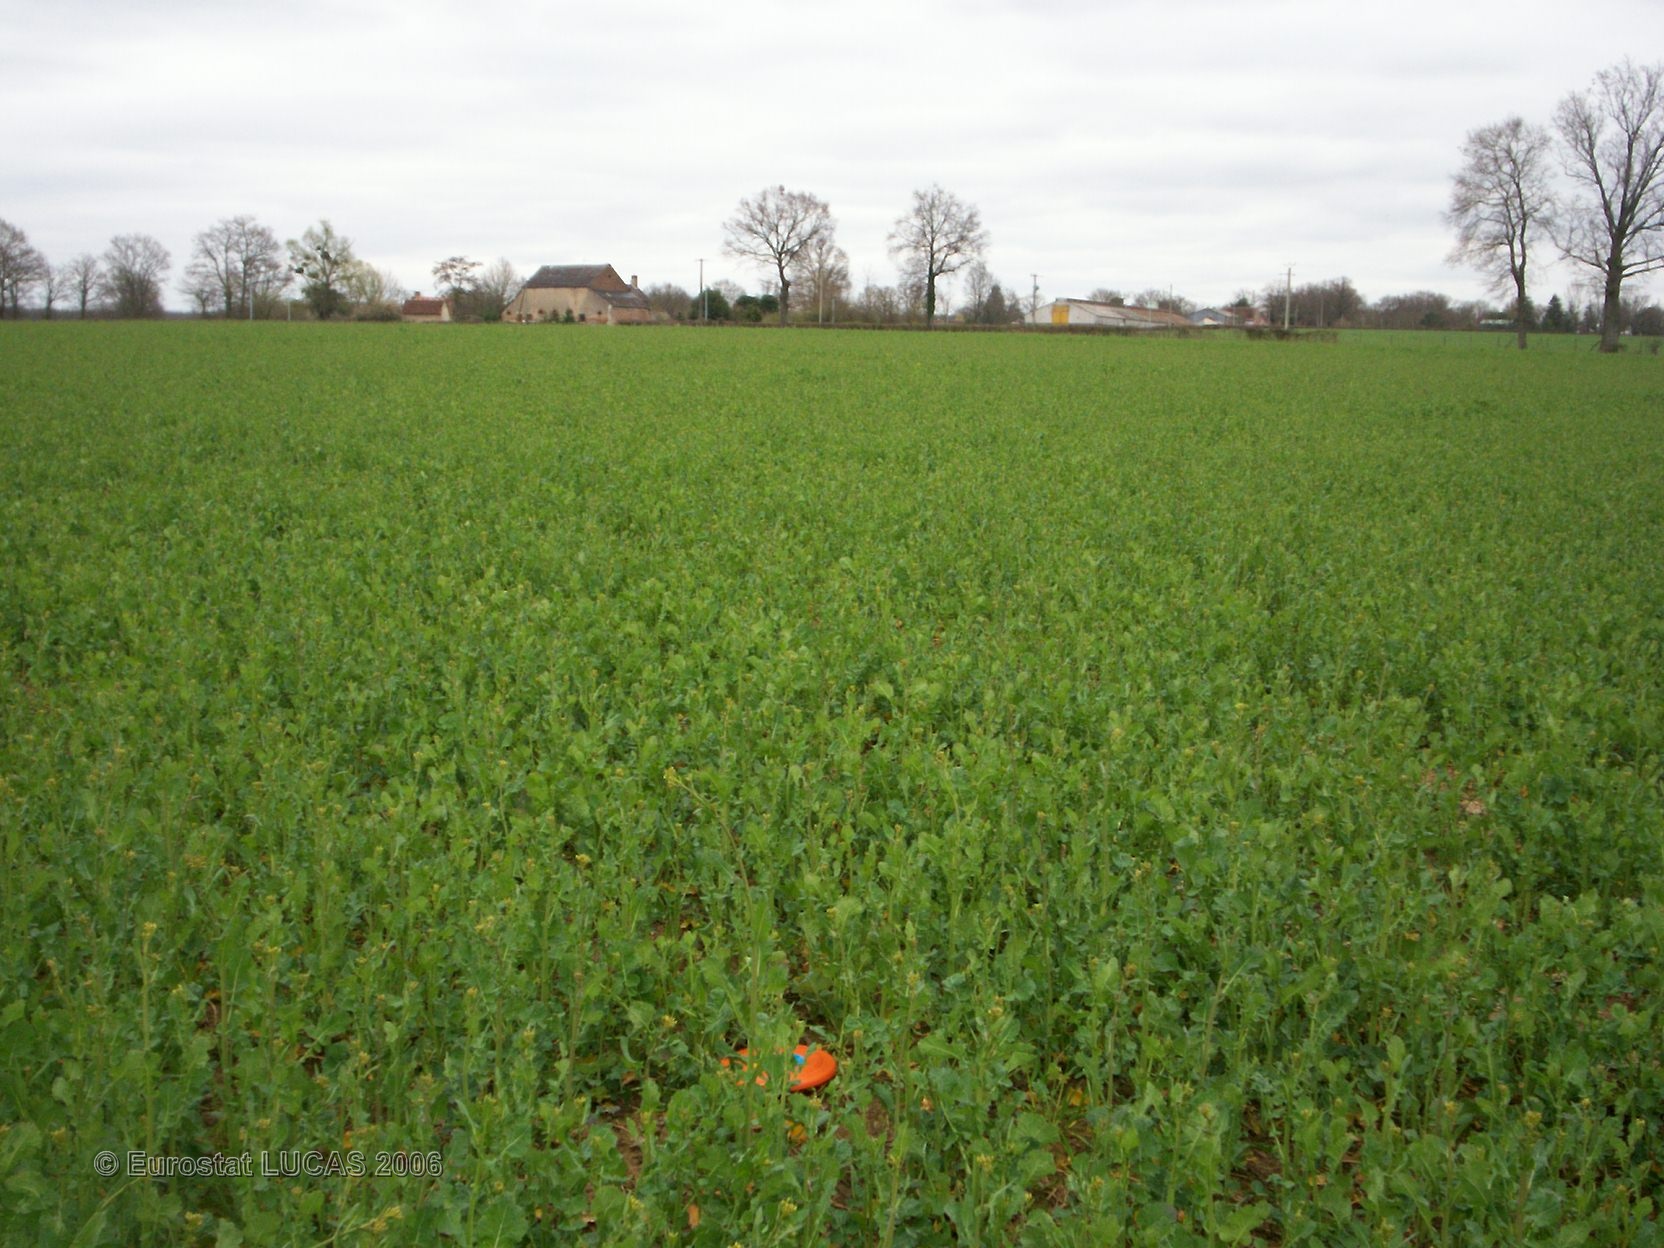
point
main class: Cropland
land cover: Rape and turnip rape
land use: Agriculture (excluding fallow land and kitchen gardens)
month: April
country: FR
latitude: 46.7035
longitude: 3.0517
